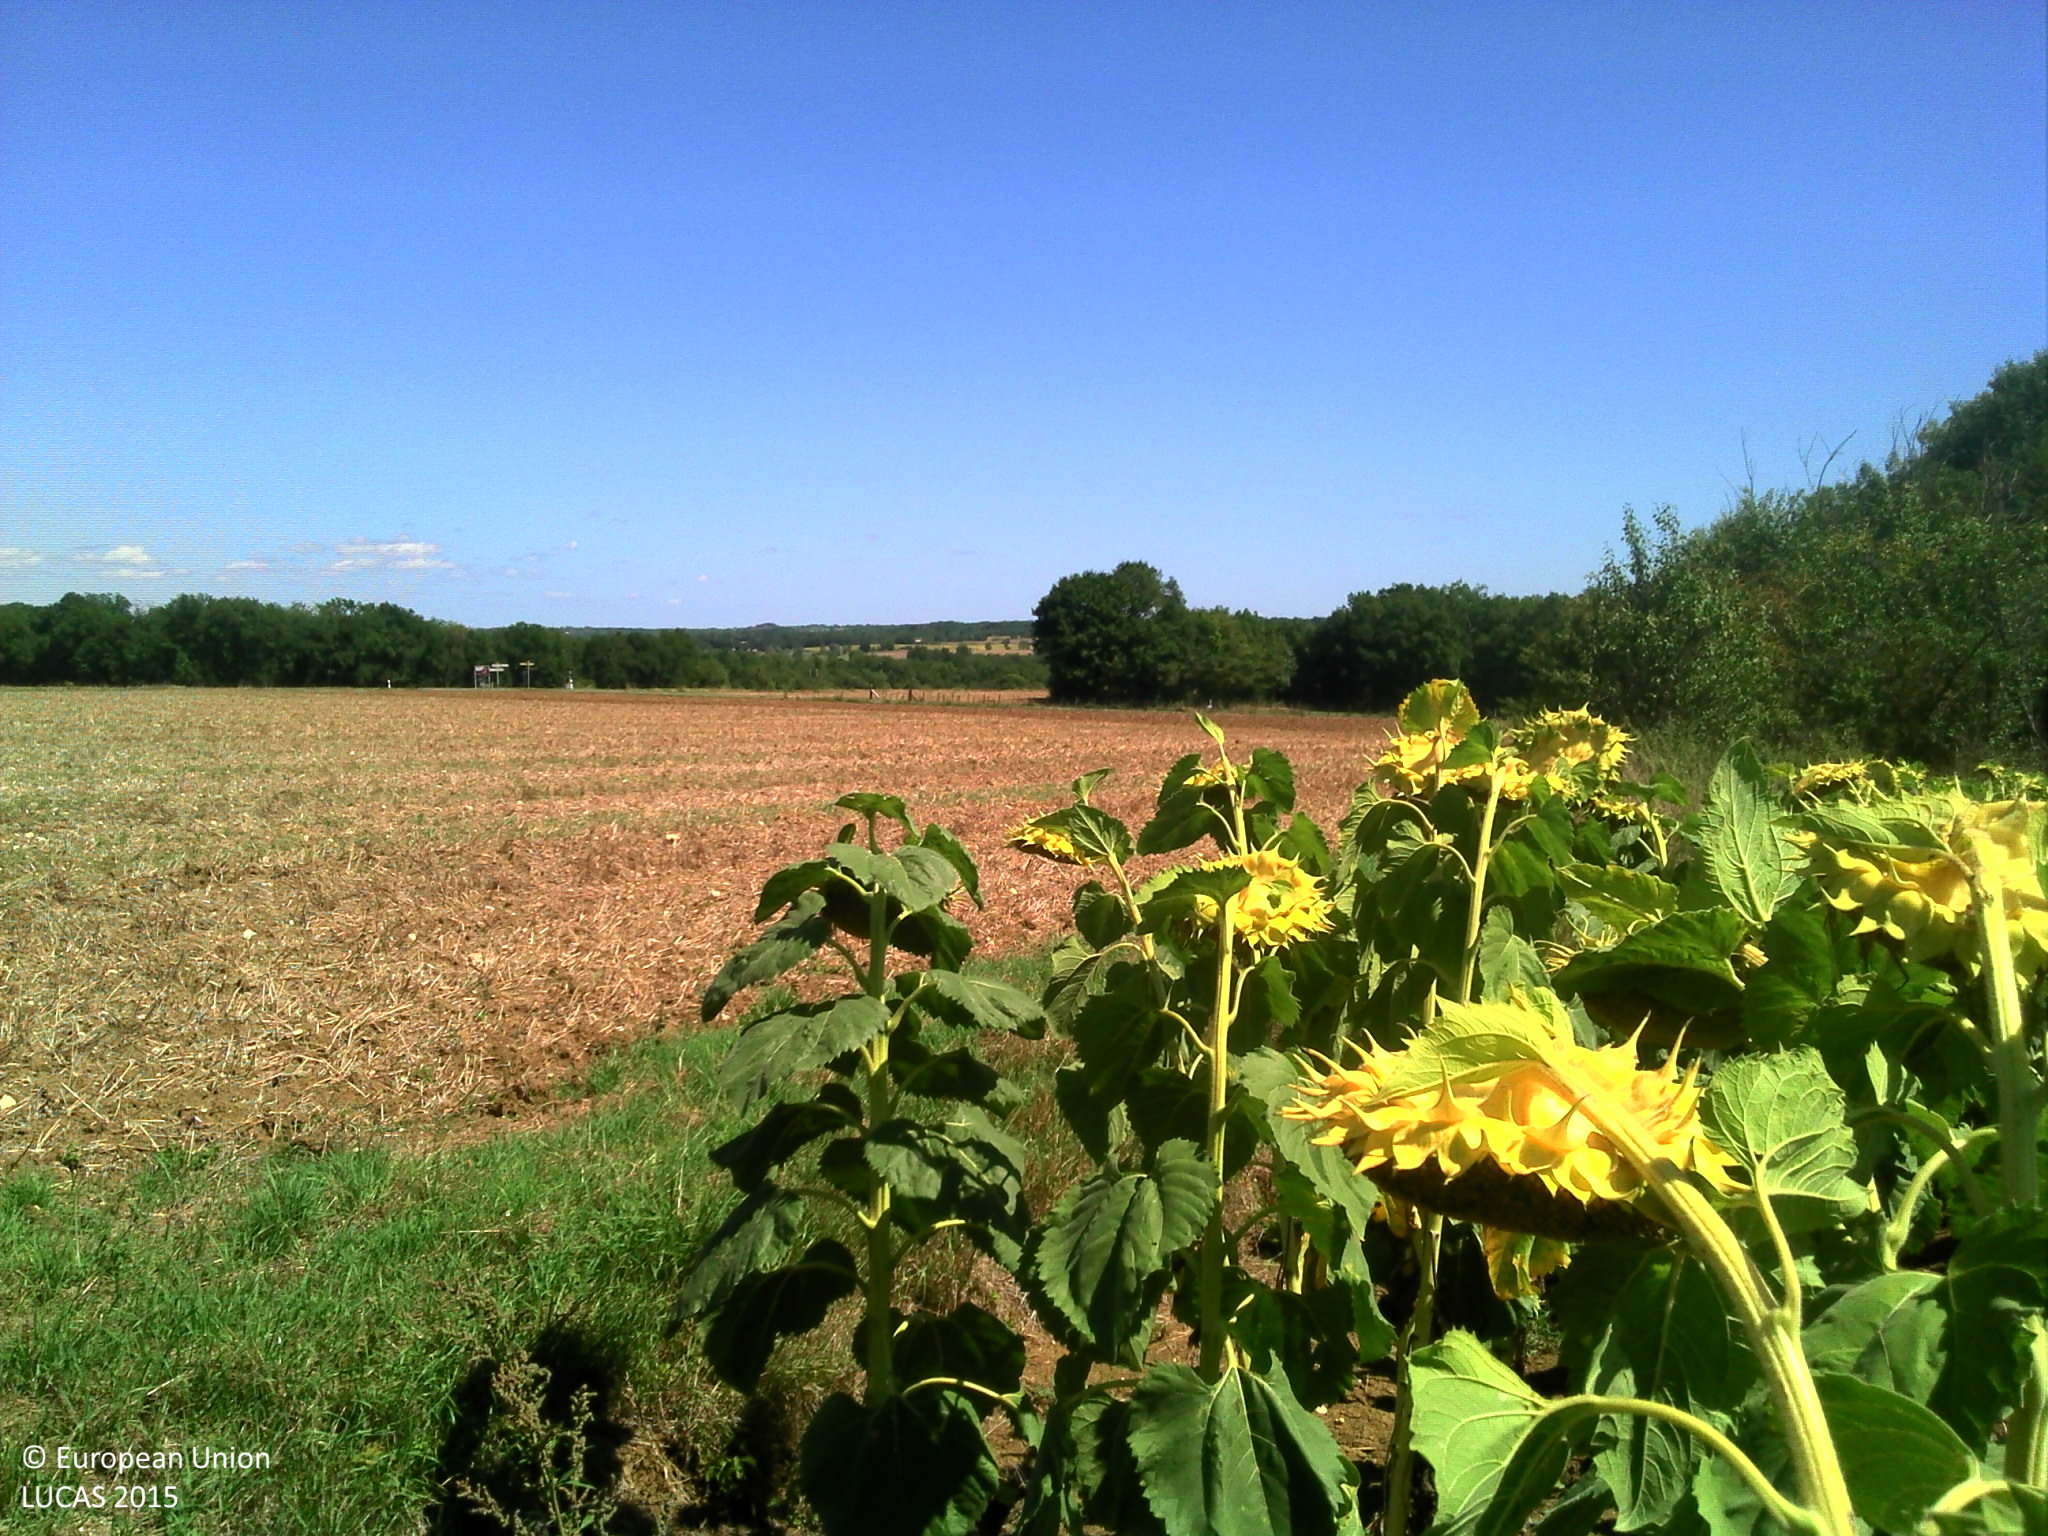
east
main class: Cropland
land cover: Sunflower
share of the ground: > 75 %
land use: Agriculture (excluding fallow land and kitchen gardens)
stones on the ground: < 10 %
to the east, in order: Sunflower; Grass margins; Other bare soil; Grass margins; Ditches and canals; Grass margins; Paved roads, cycling and walking lanes; Grass margins; Fences; Grassland without tree/shrub cover; Fences; Grass margins; Tracks; Grass margins; Broadleaved woodland
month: August
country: FR
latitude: 44.2905
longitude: 1.4898
